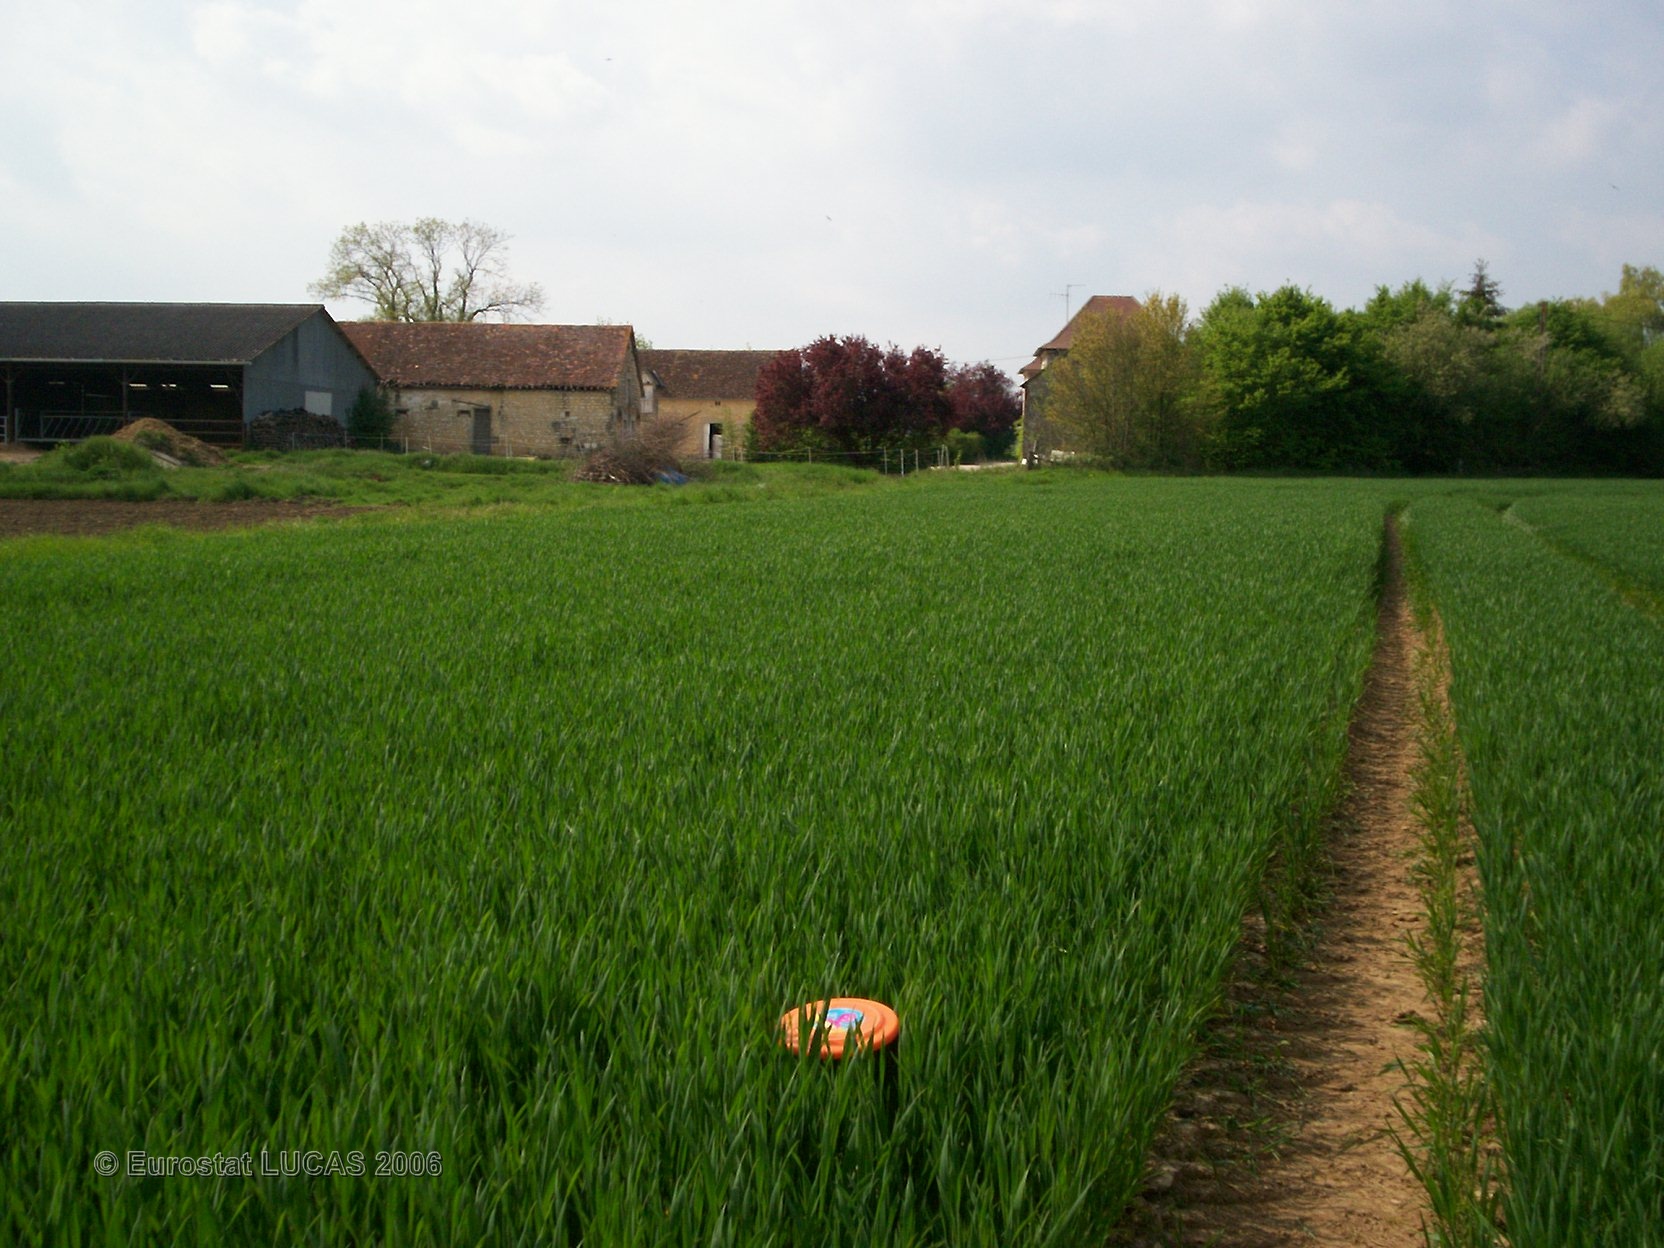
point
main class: Cropland
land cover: Common wheat
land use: Agriculture (excluding fallow land and kitchen gardens)
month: May
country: FR
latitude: 48.5191
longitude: 0.2930
